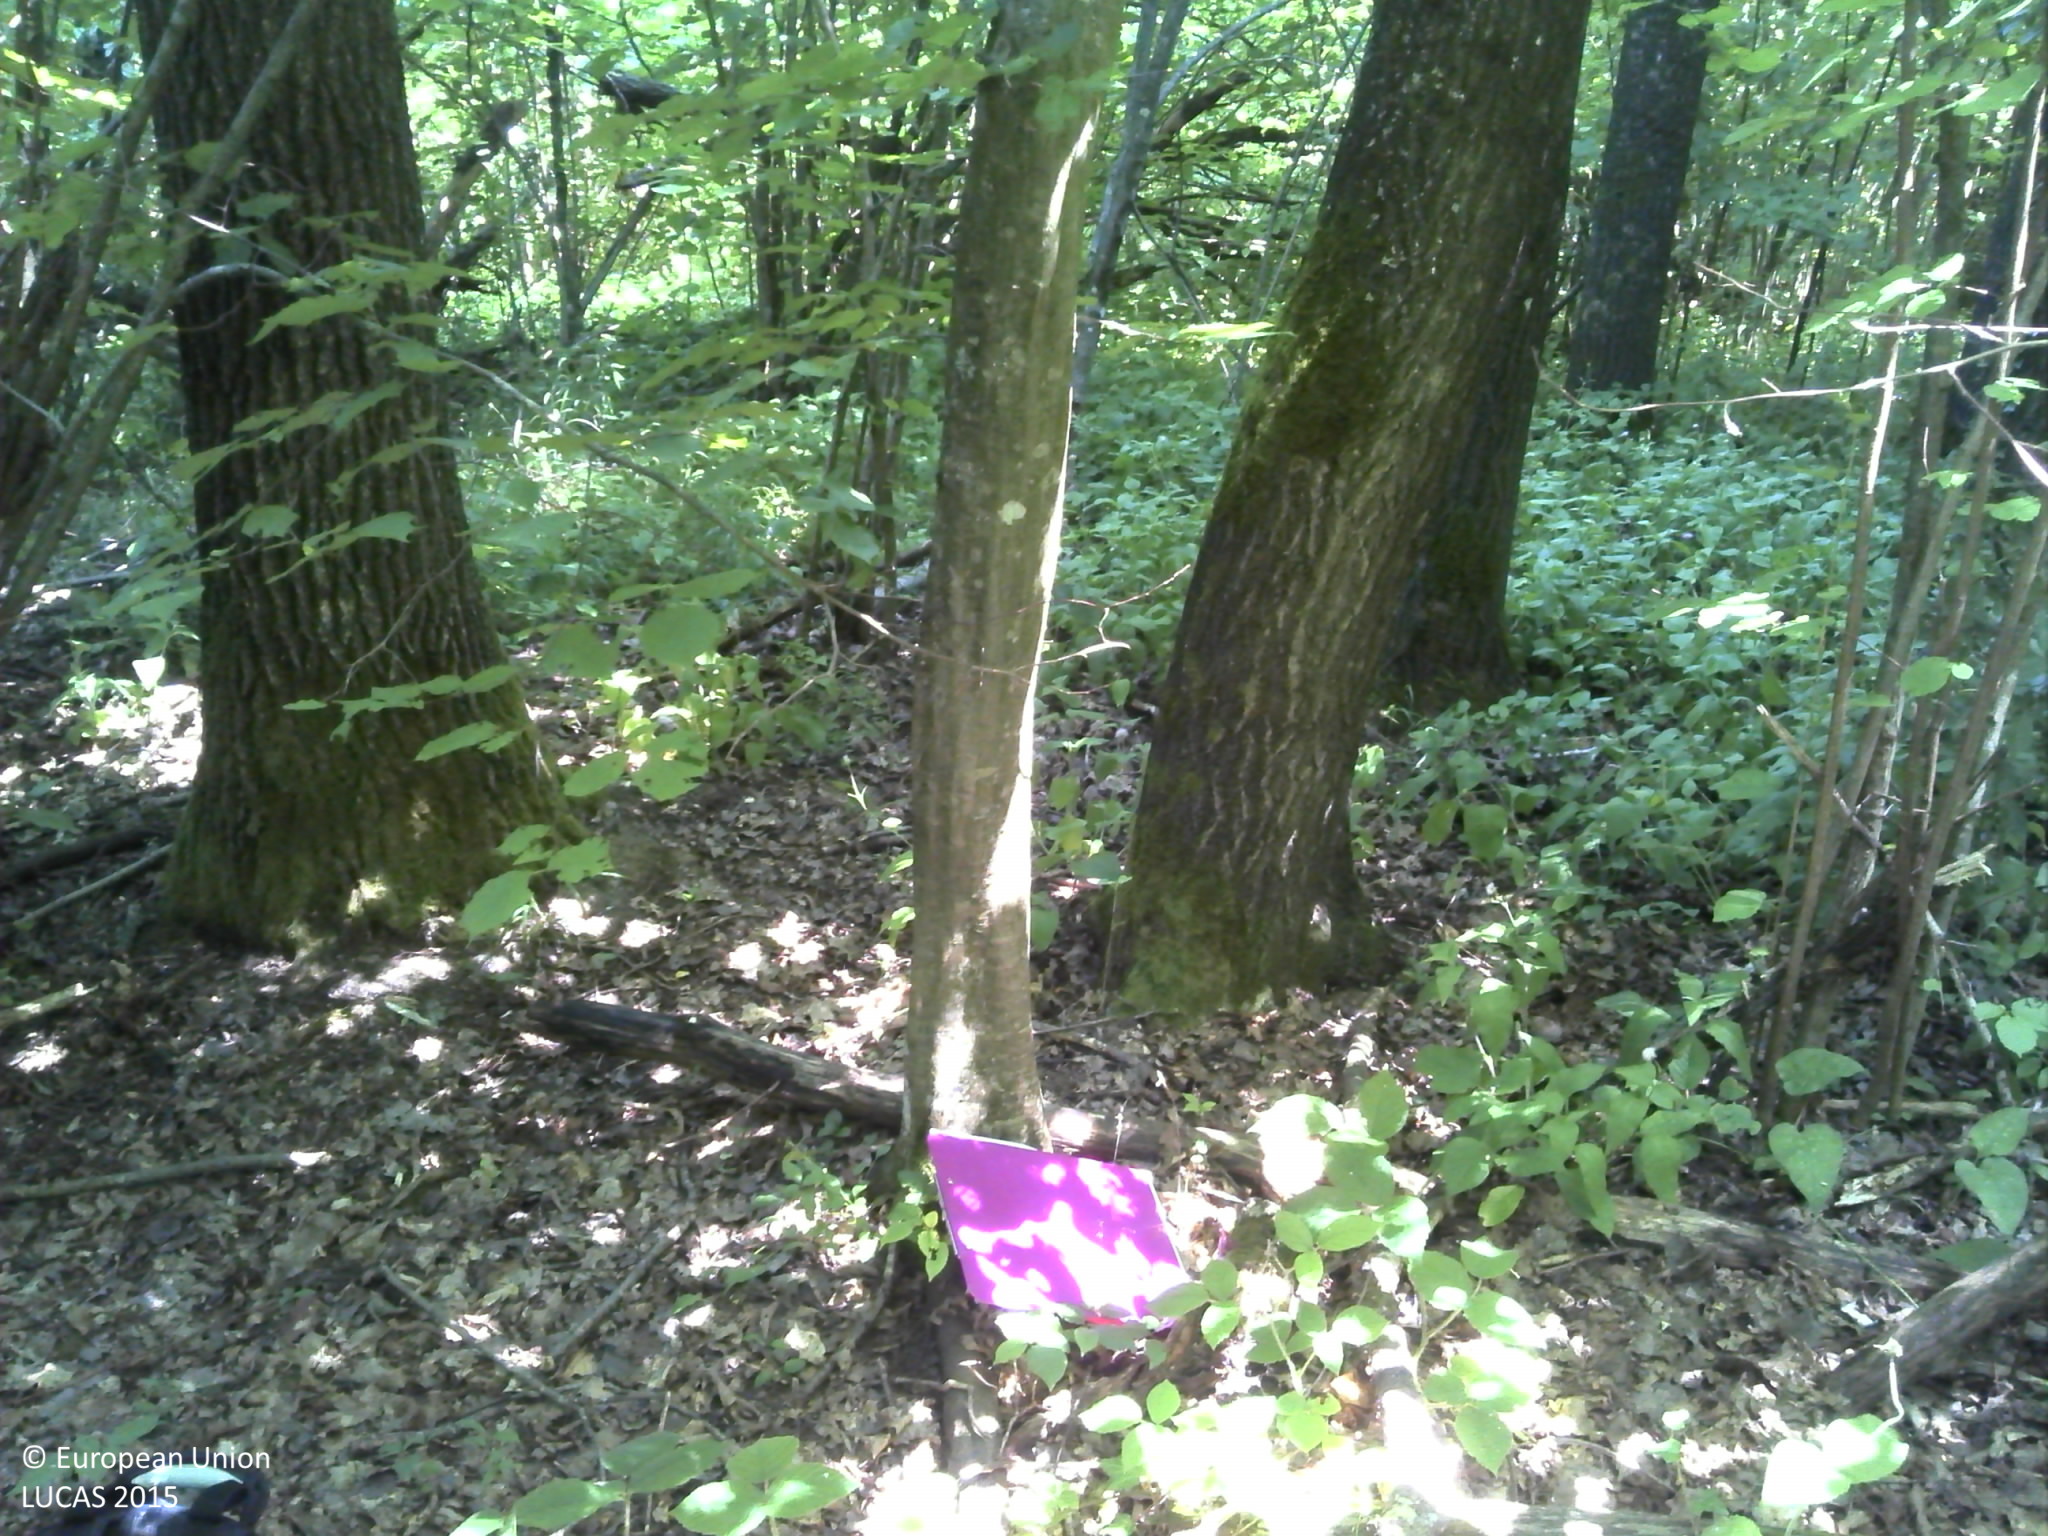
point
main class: Woodland
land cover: Broadleaved woodland
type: acidophilous oak and oak-birch forest
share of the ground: > 75 %
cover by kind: broadleaved forest trees 90 %, shrubs 5 %, herbaceous plants 5 %
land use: Forestry
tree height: > 5 m
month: July
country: HR
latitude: 45.7421
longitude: 16.7216
